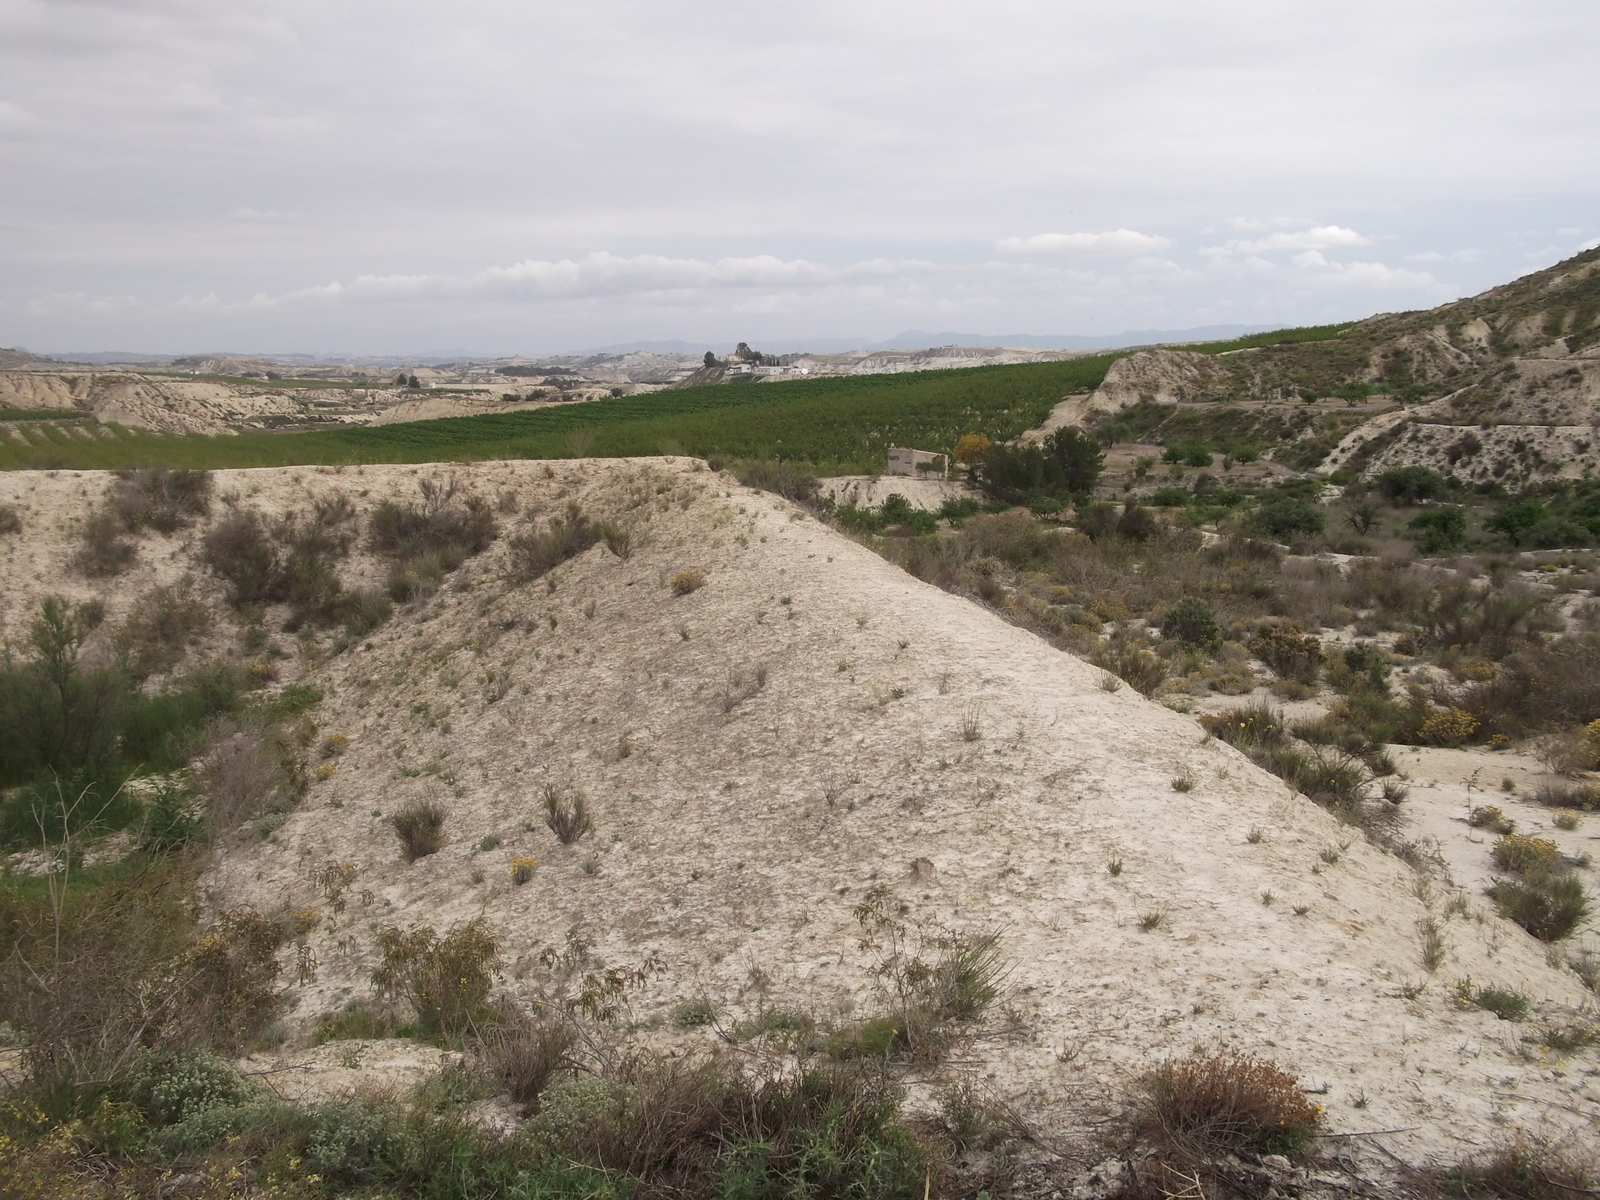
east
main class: Cropland
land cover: Nuts trees
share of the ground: 10 - 25 %
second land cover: Other bare soil
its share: > 75 %
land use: Agriculture (excluding fallow land and kitchen gardens)
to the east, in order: Nuts trees; Other bare soil; Shrubland without tree cover; Fences; Other fruit trees and berries; Grass margins; Paved roads, cycling and walking lanes
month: April
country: ES
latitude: 38.0511
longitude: -1.3703
